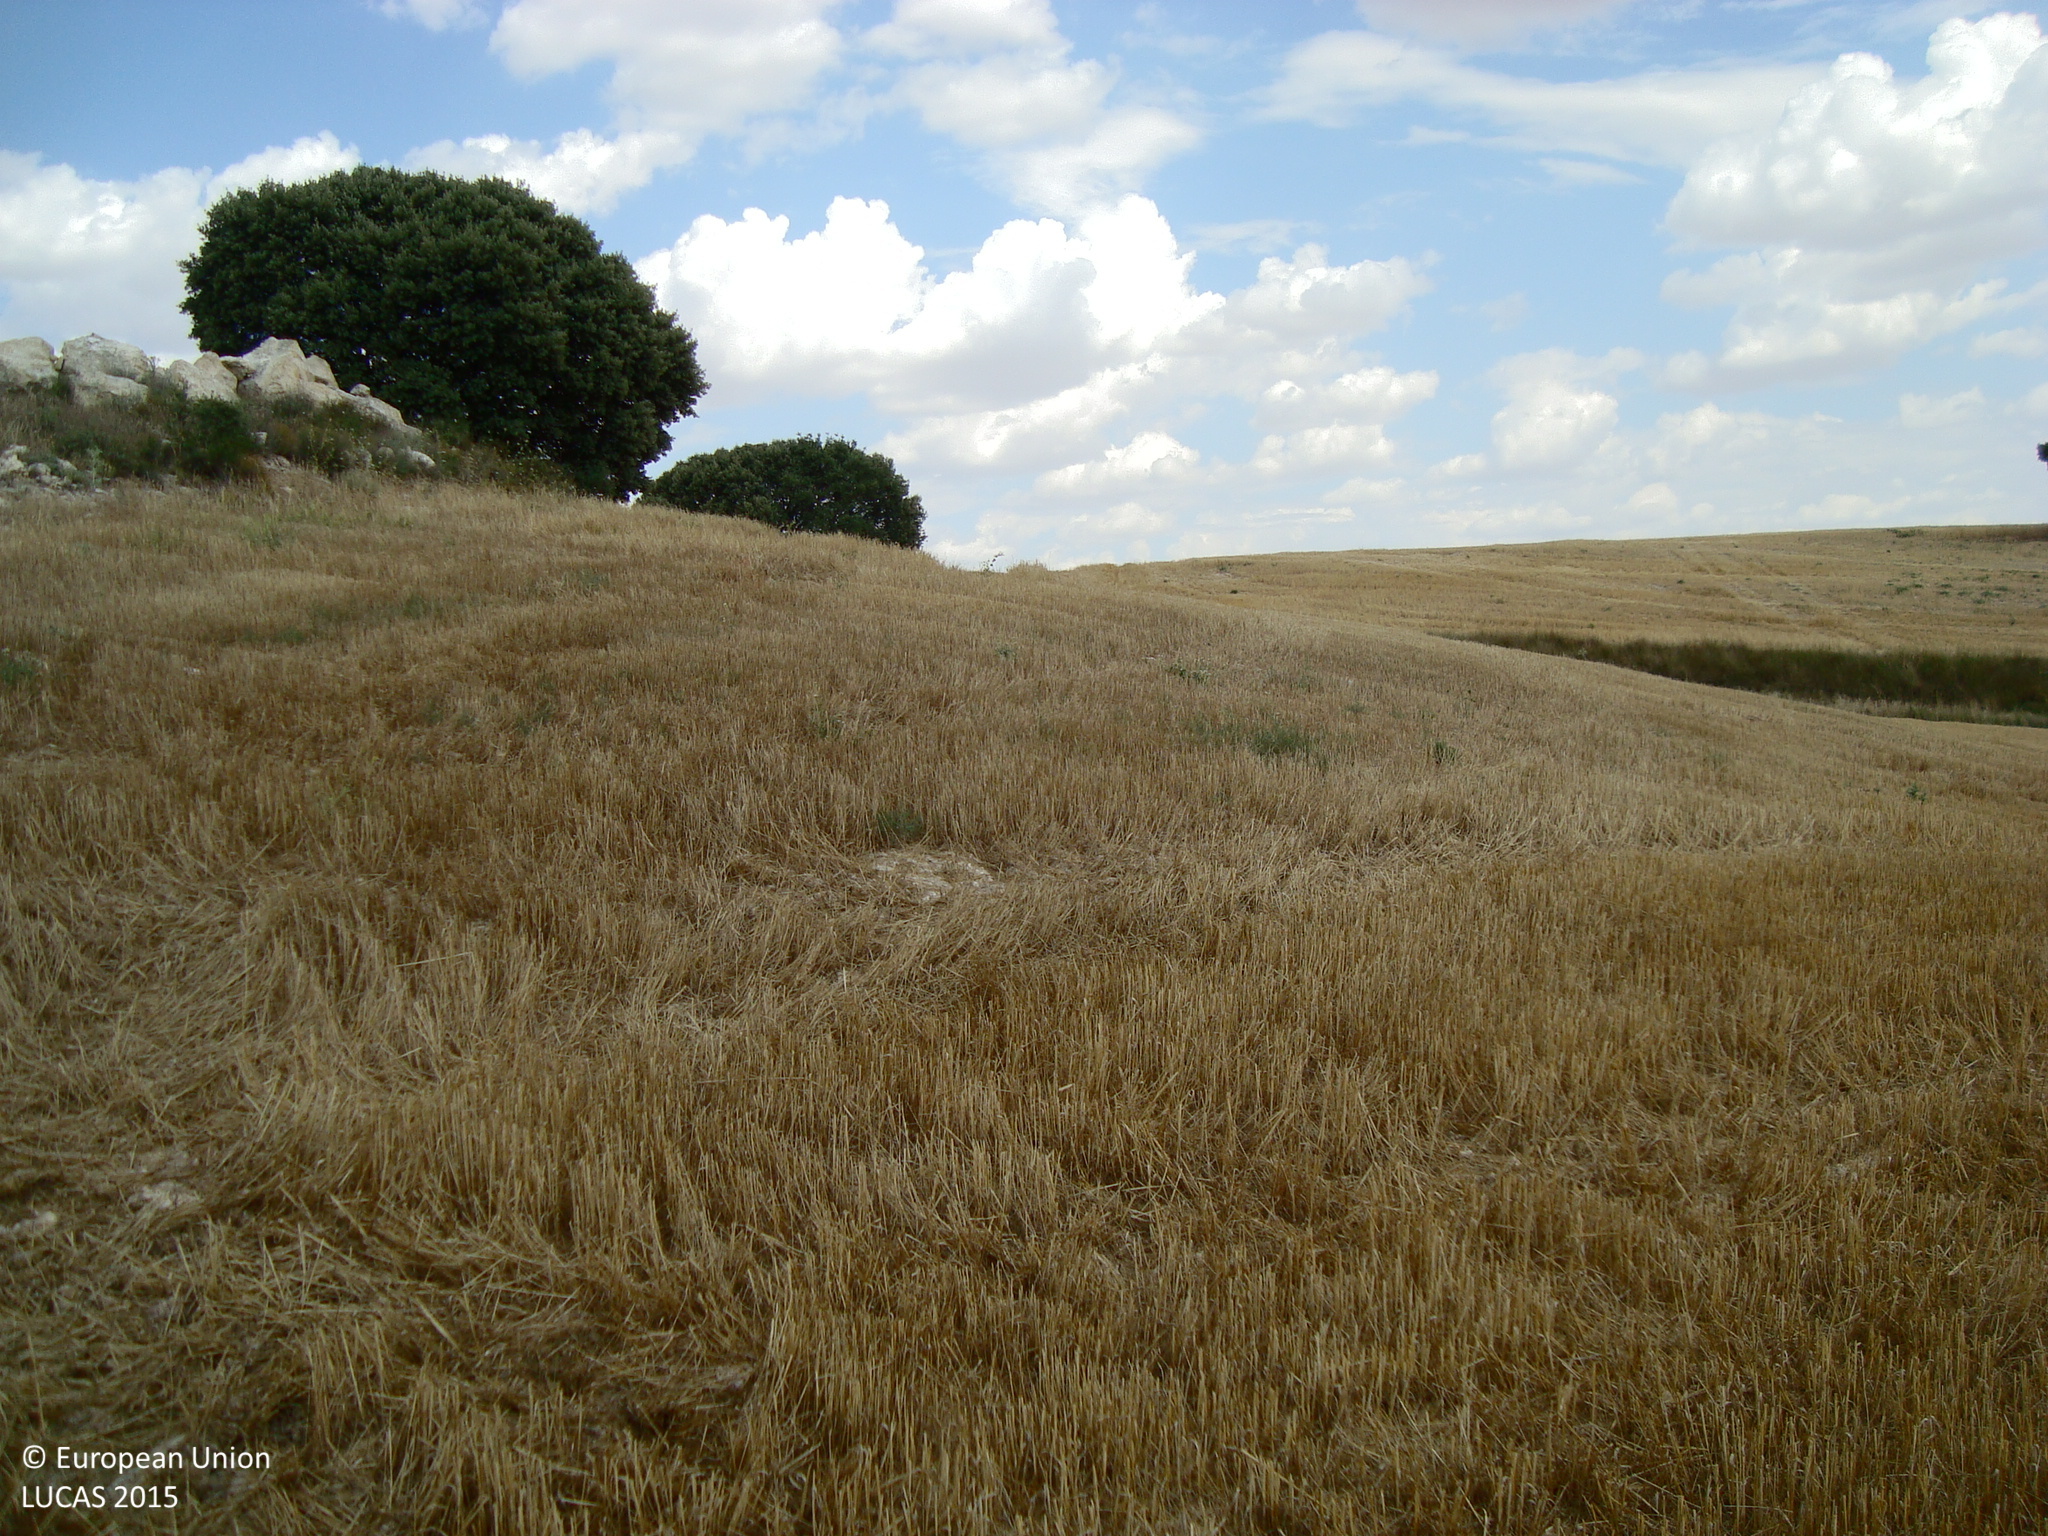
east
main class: Cropland
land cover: Barley
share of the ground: > 75 %
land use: Agriculture (excluding fallow land and kitchen gardens)
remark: Harvested field
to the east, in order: Barley; Grassland with sparse tree/shrub cover; Barley; Grassland with sparse tree/shrub cover; Barley; Common wheat; Pine dominated coniferous woodland
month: July
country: ES
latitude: 41.9559
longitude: -4.0932
